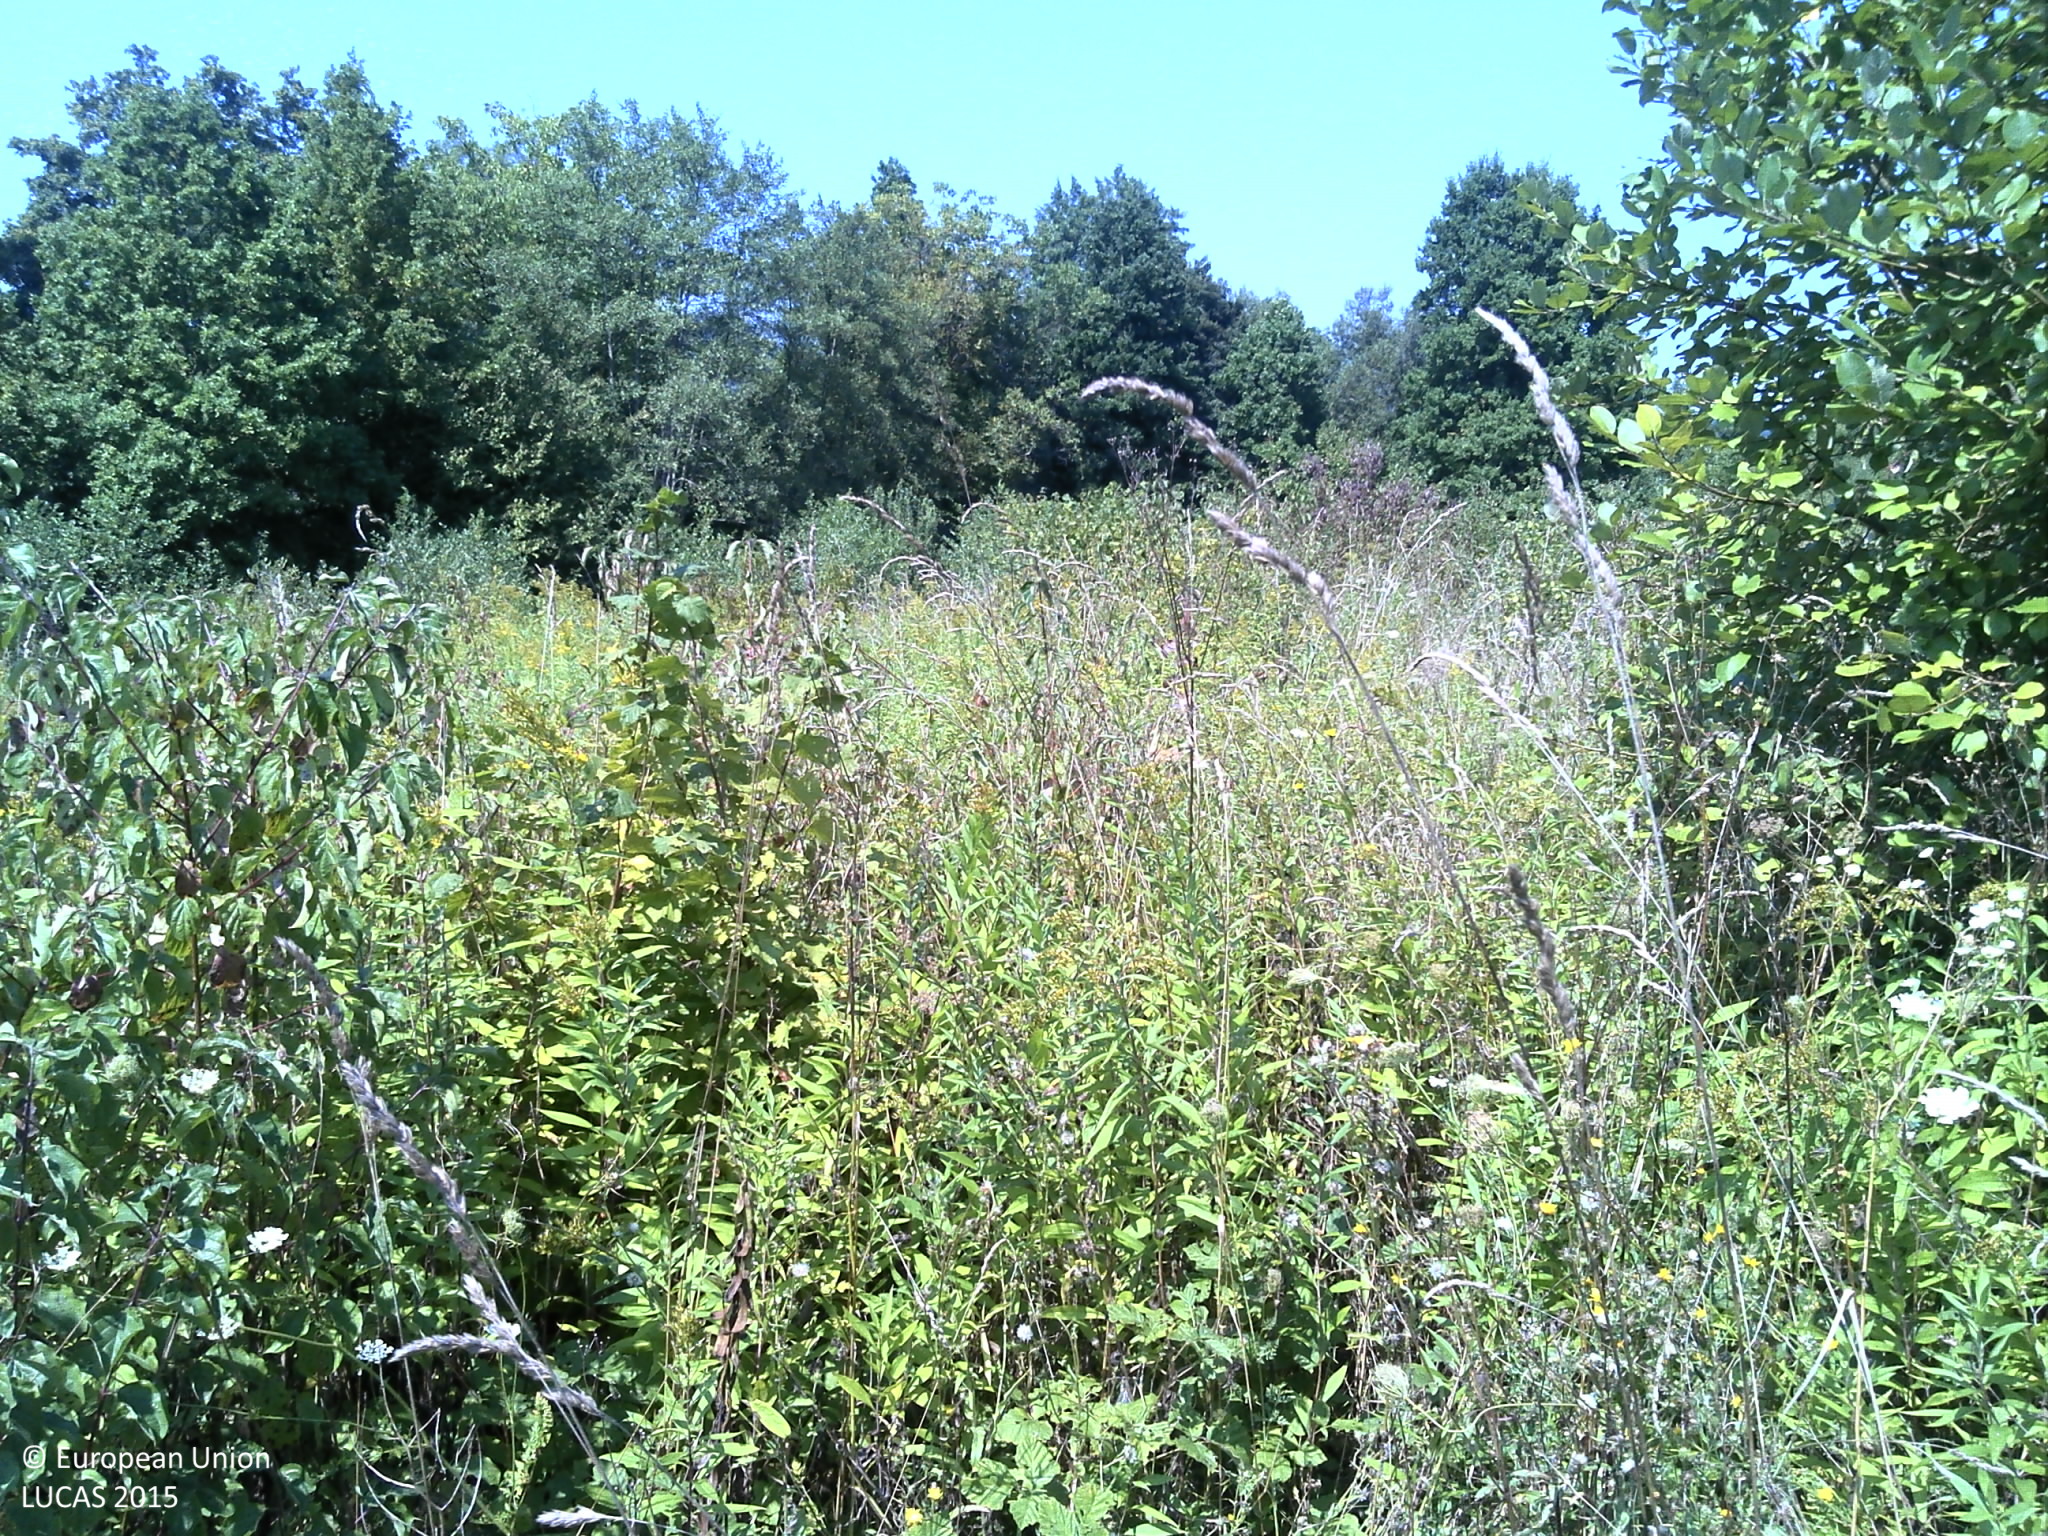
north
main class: Shrubland
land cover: Shrubland with sparse tree cover
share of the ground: > 75 %
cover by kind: shrubs 95 %, broadleaved forest trees 5 %
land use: Semi-natural and natural areas not in use
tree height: < 5 m
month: August
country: HR
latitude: 45.1447
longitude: 16.4449
